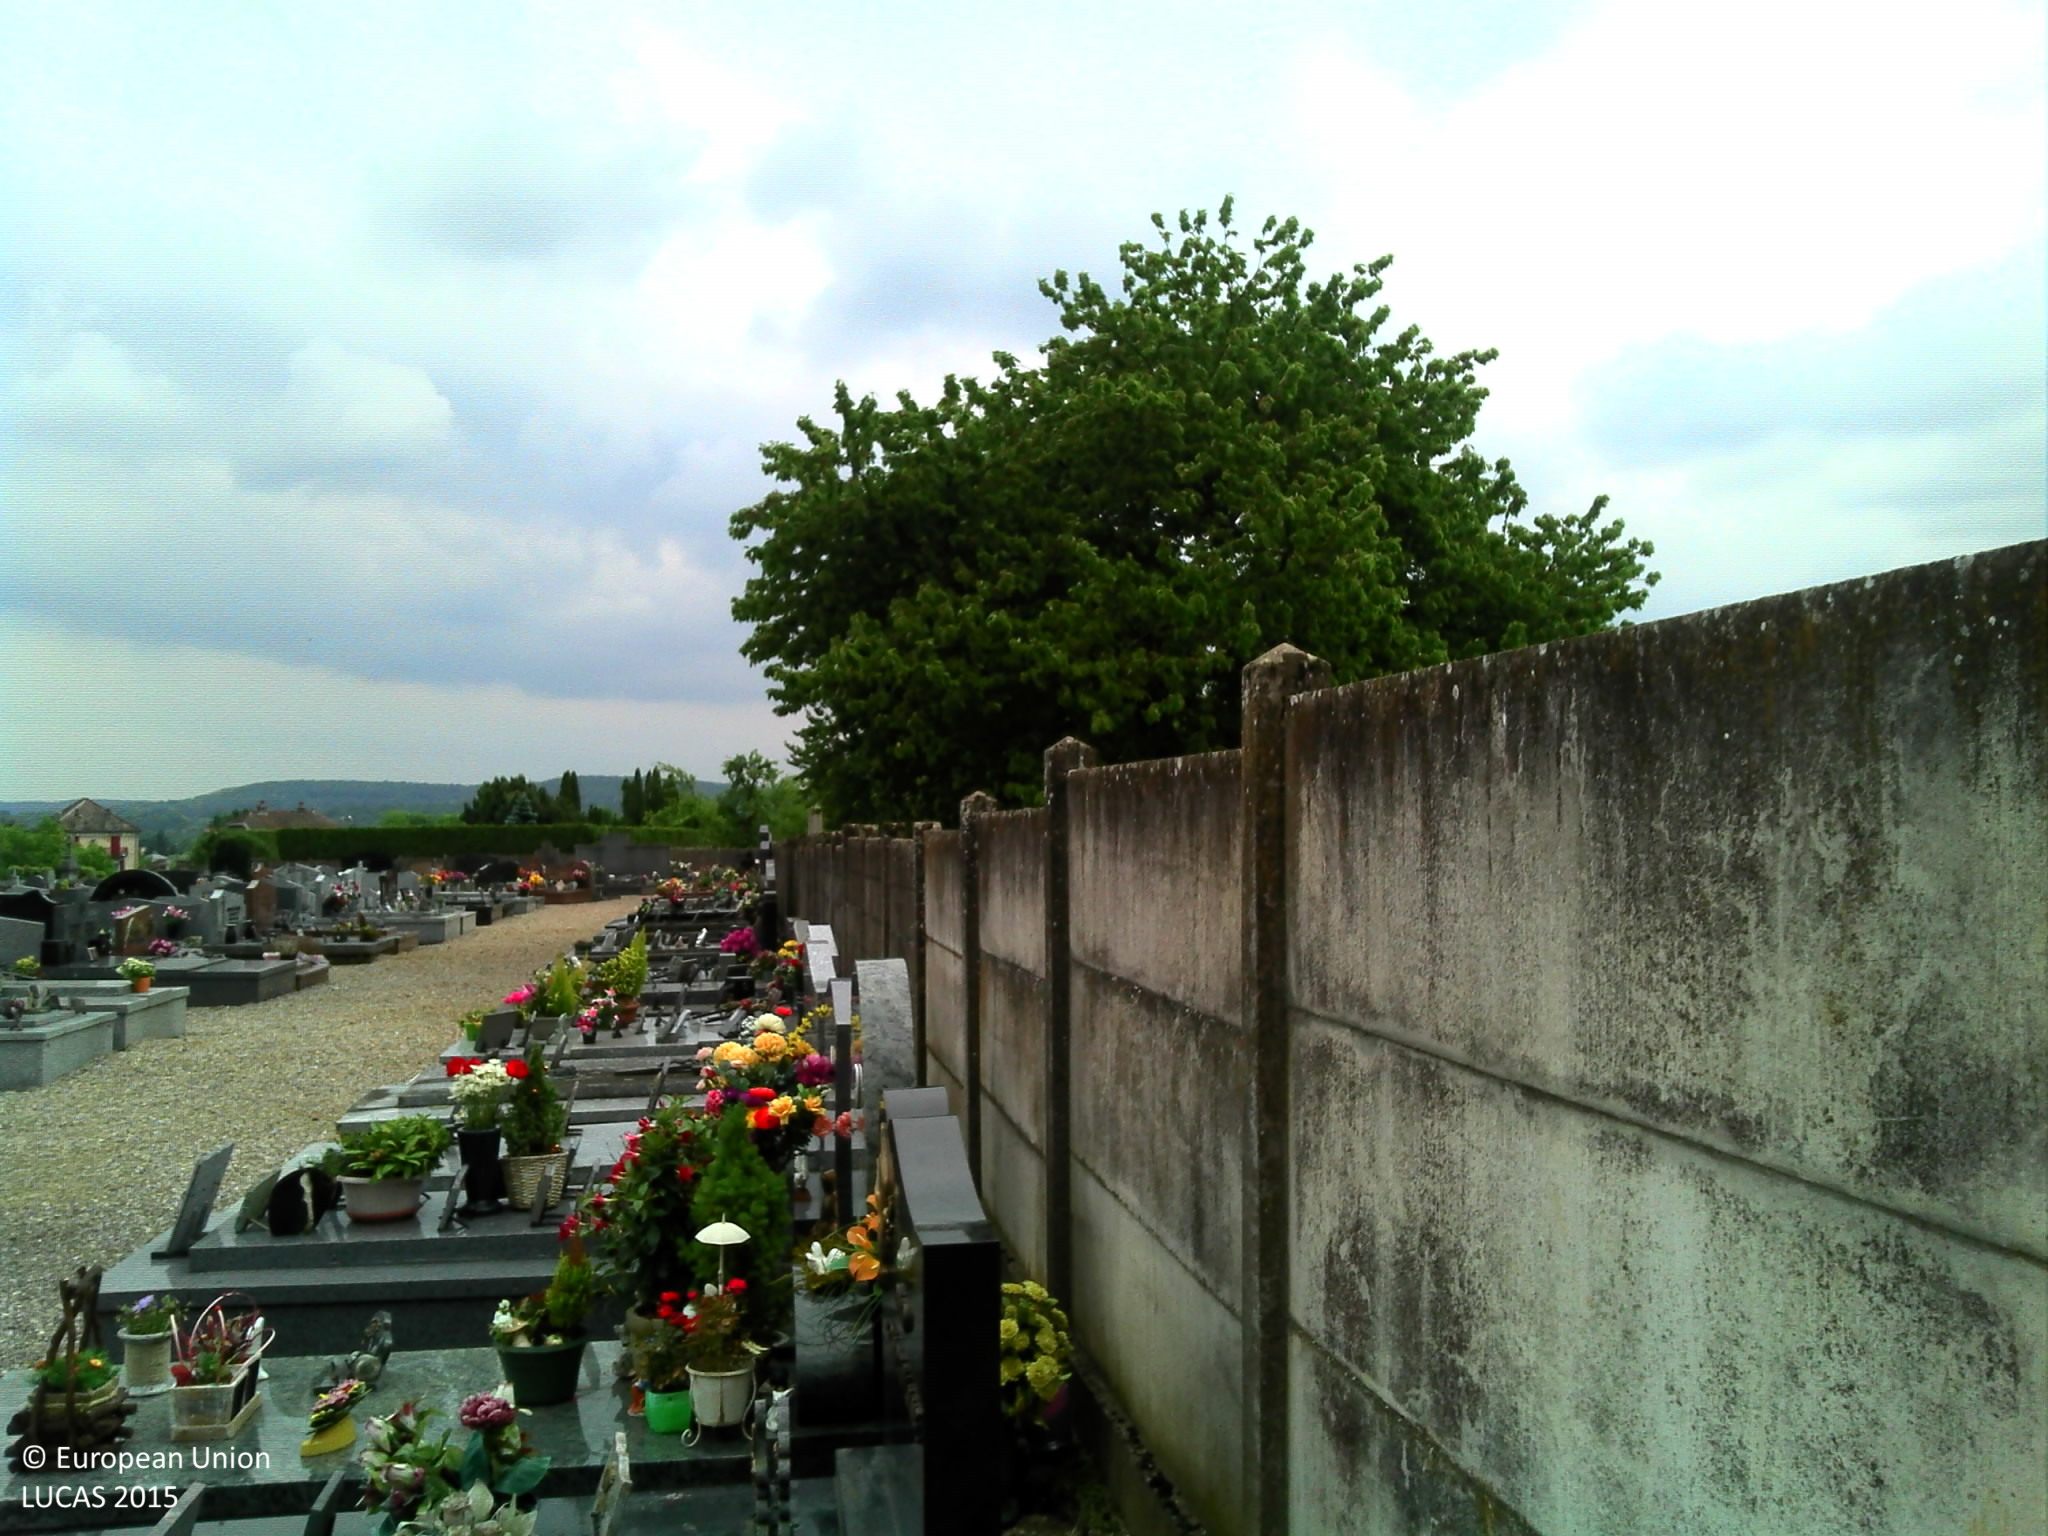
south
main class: Grassland
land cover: Grassland with sparse tree/shrub cover
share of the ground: > 75 %
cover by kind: herbaceous plants 95 %, broadleaved forest trees 5 %
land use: Agriculture (excluding fallow land and kitchen gardens)
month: May
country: FR
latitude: 47.8902
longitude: 6.2695
